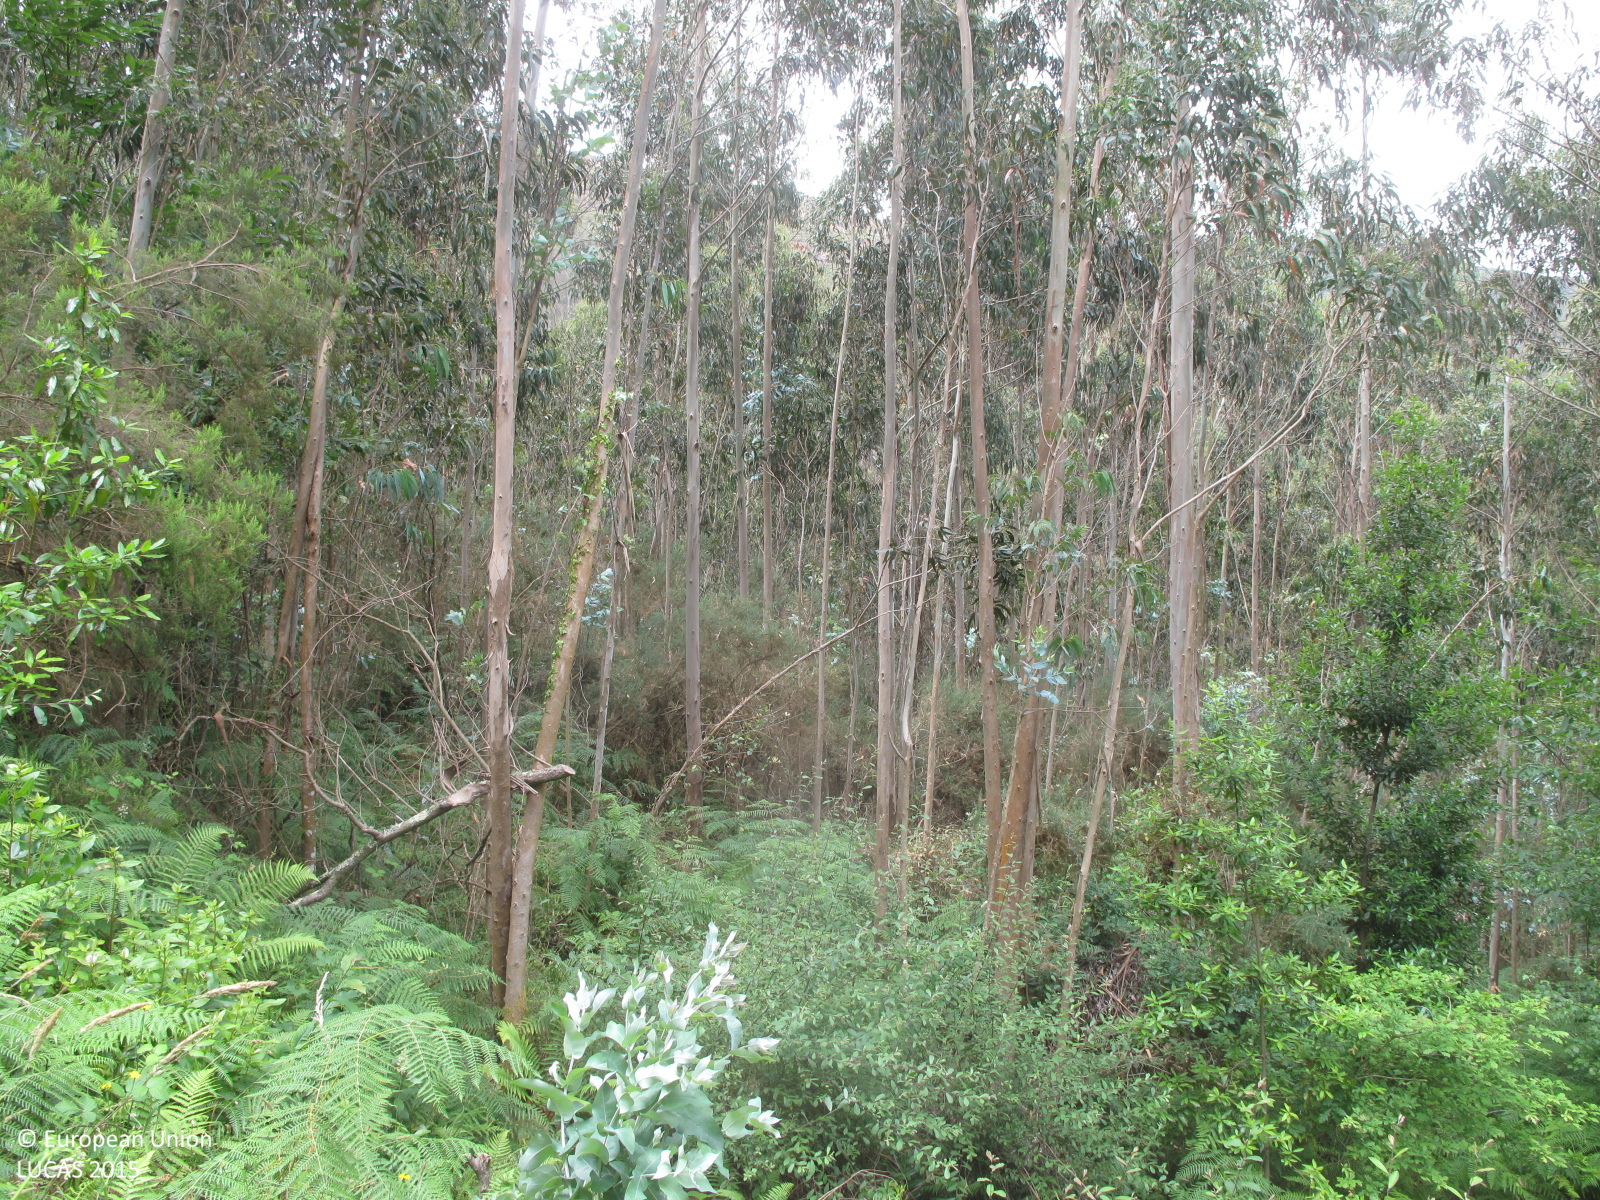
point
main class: Woodland
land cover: Broadleaved woodland
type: exotic forest
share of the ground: > 75 %
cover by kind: broadleaved forest trees 90 %, shrubs 10 %
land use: Forestry
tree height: > 5 m
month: July
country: ES
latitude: 43.4826
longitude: -8.0880
